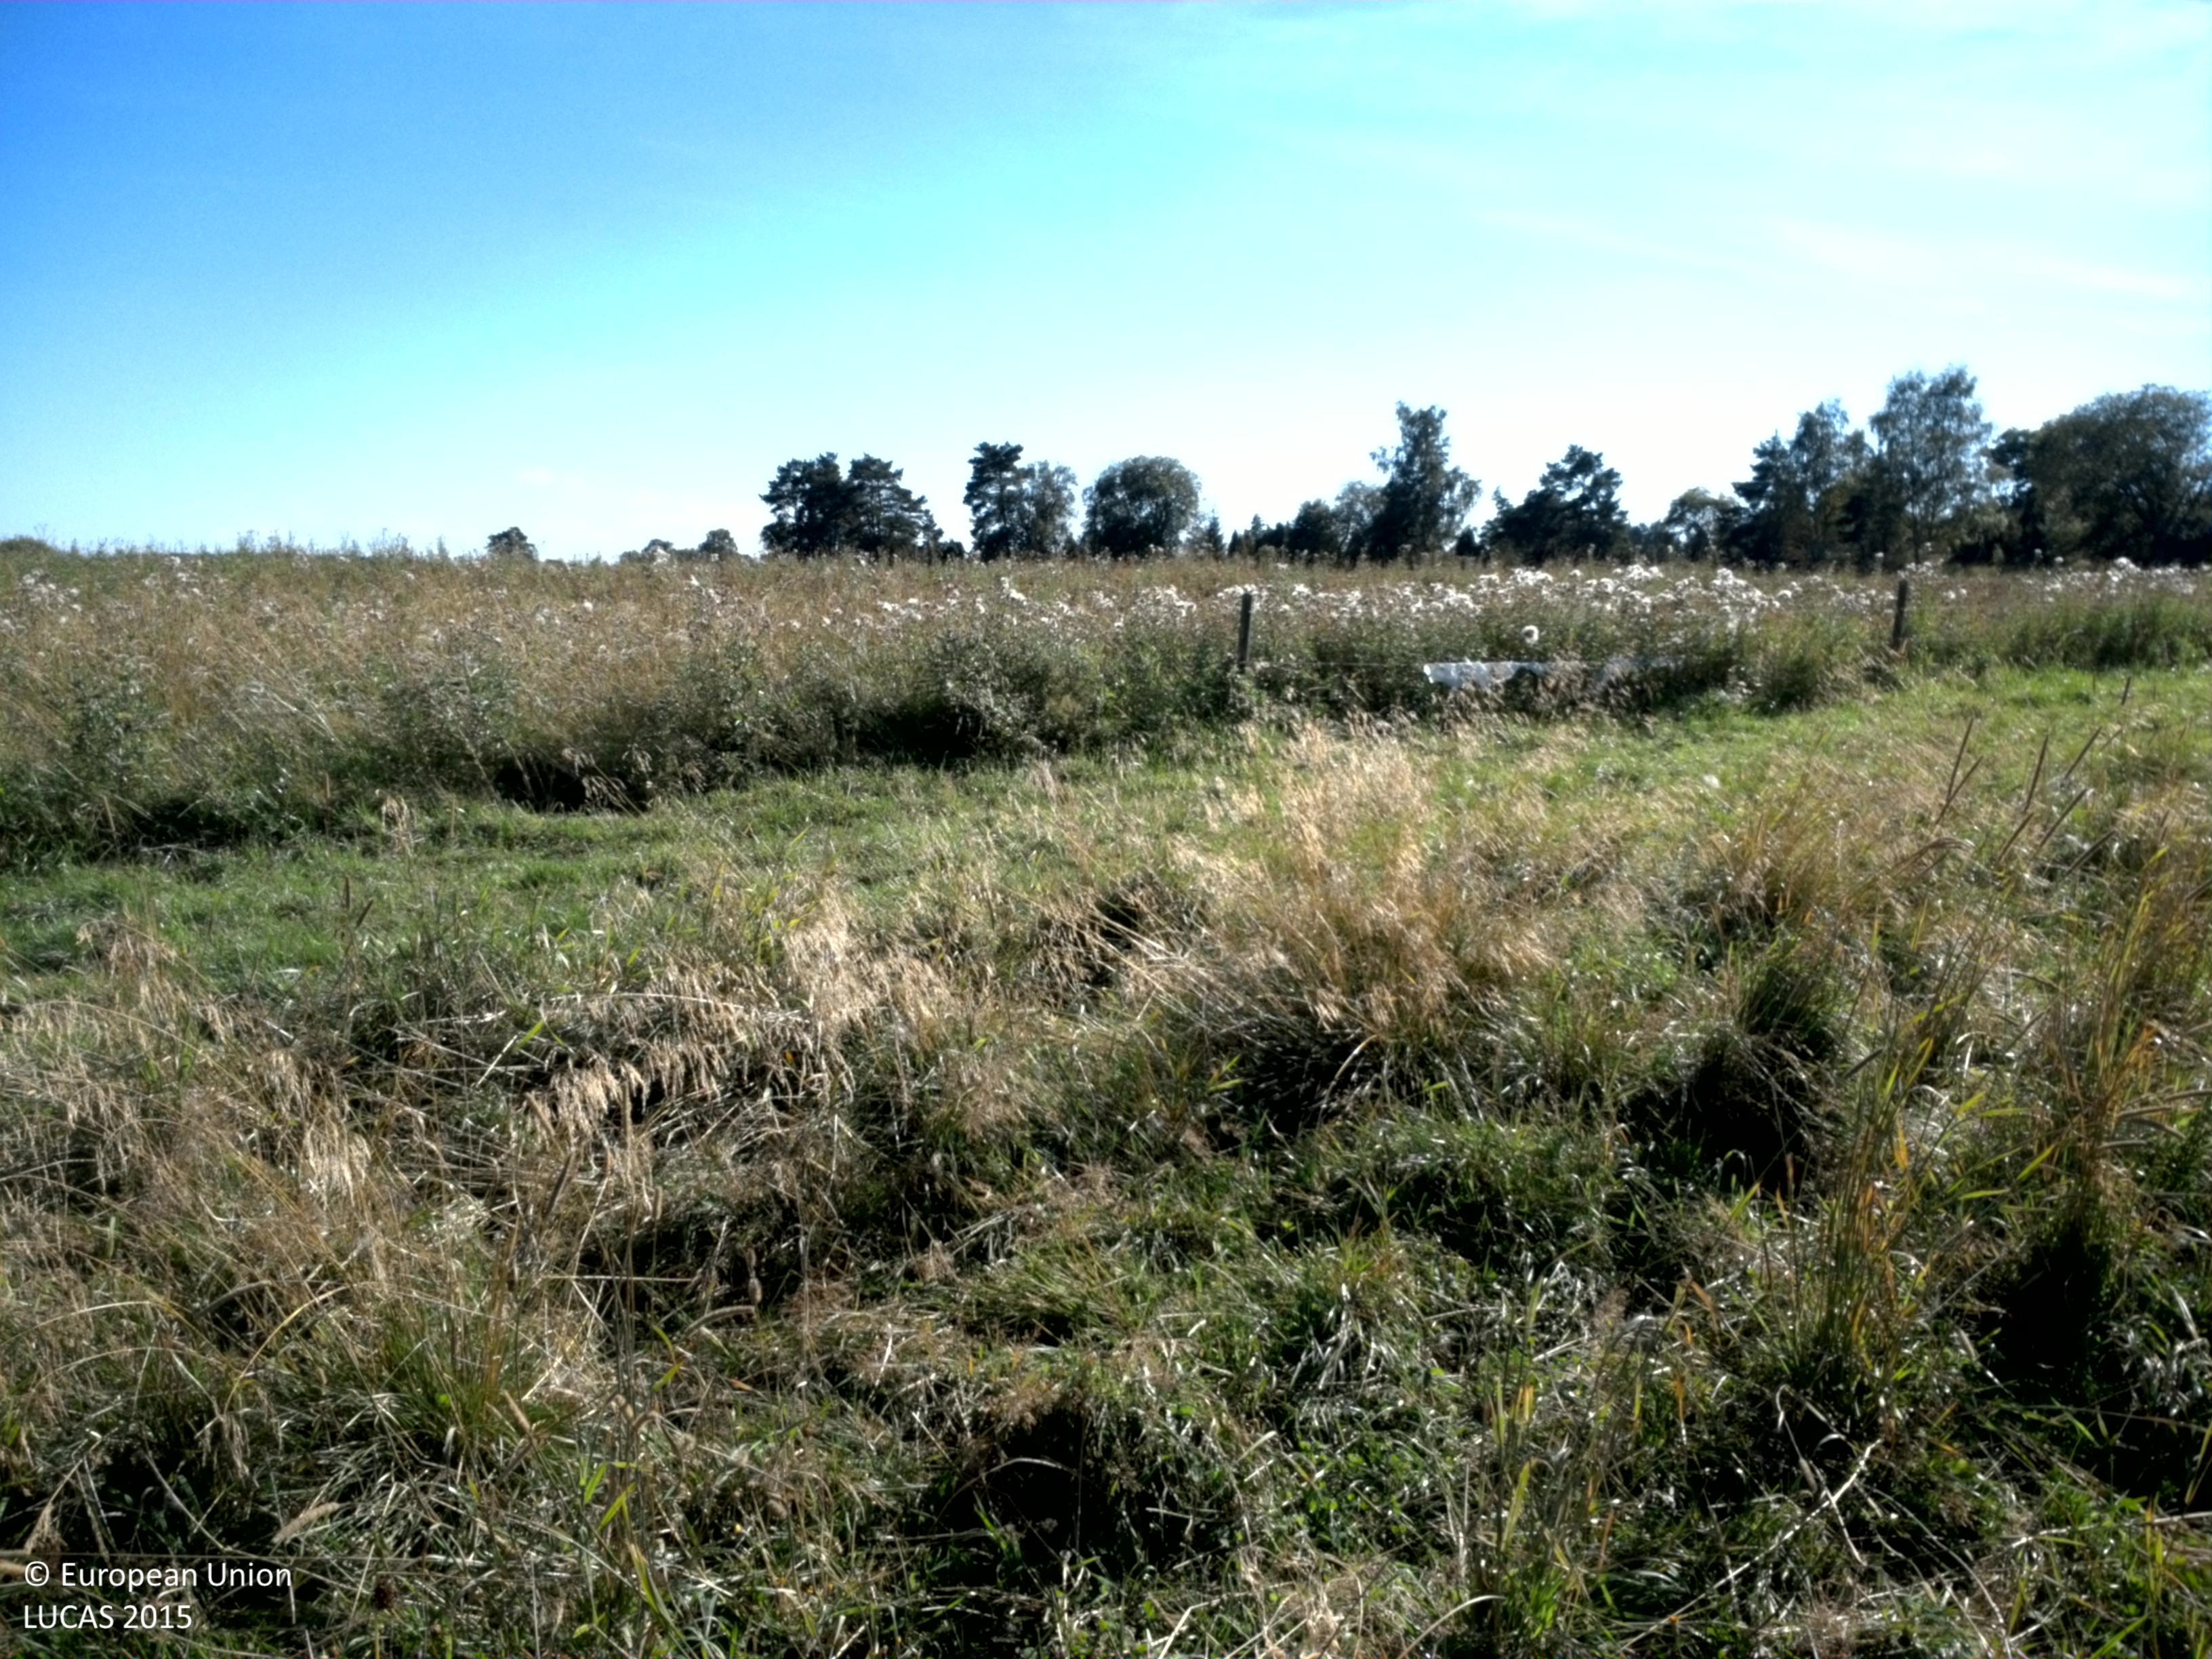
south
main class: Grassland
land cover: Grassland without tree/shrub cover
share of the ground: > 75 %
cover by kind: herbaceous plants 100 %
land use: Agriculture (excluding fallow land and kitchen gardens)
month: August
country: SE
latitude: 59.7937
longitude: 16.9241
